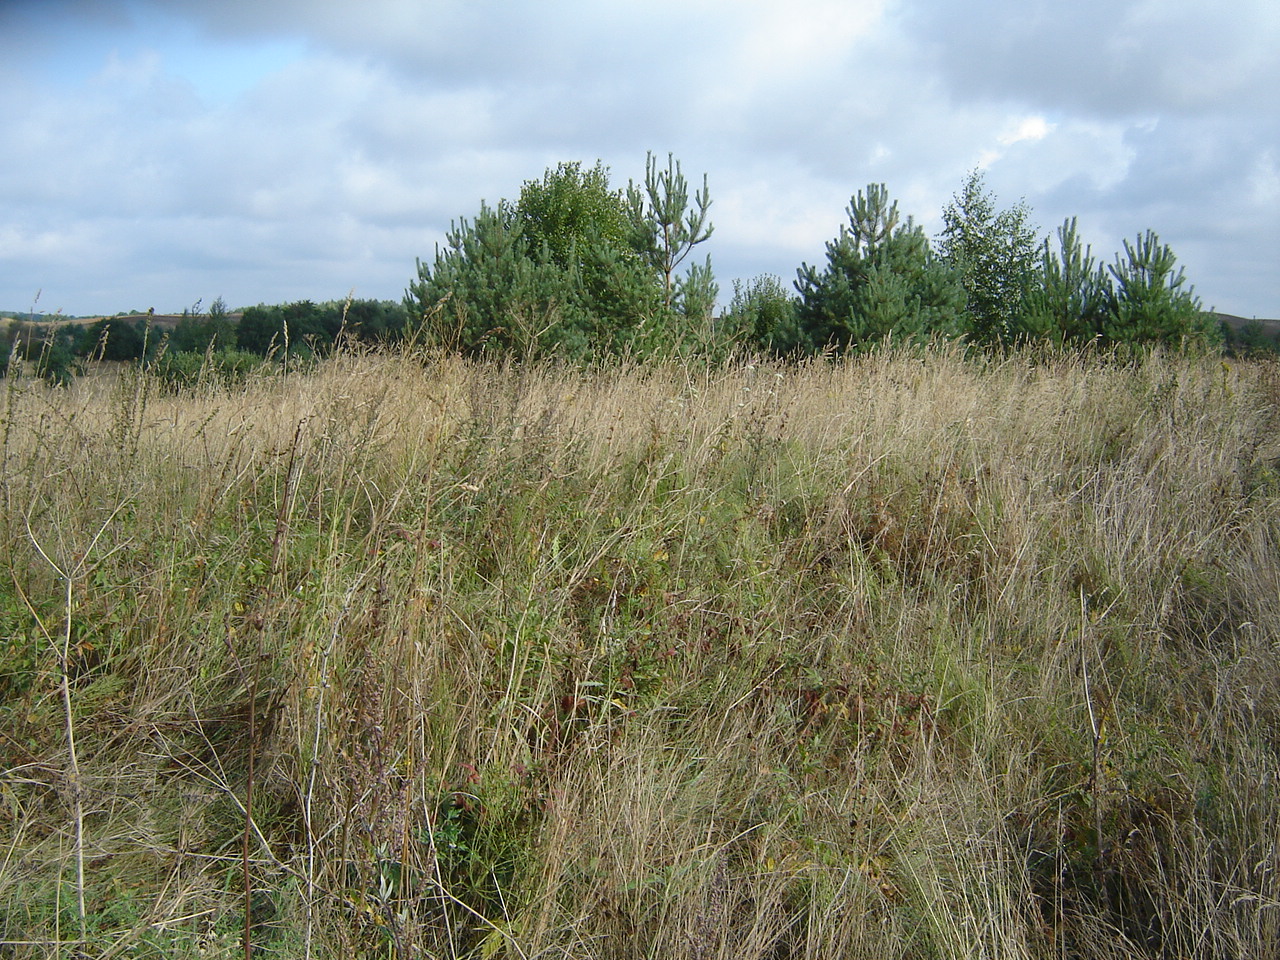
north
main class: Grassland
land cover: Grassland with sparse tree/shrub cover
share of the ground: > 75 %
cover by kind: herbaceous plants 90 %, coniferous forest trees 5 %, shrubs 5 %
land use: Fallow land
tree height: > 5 m
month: August
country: LT
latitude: 54.7280
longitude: 24.7194
